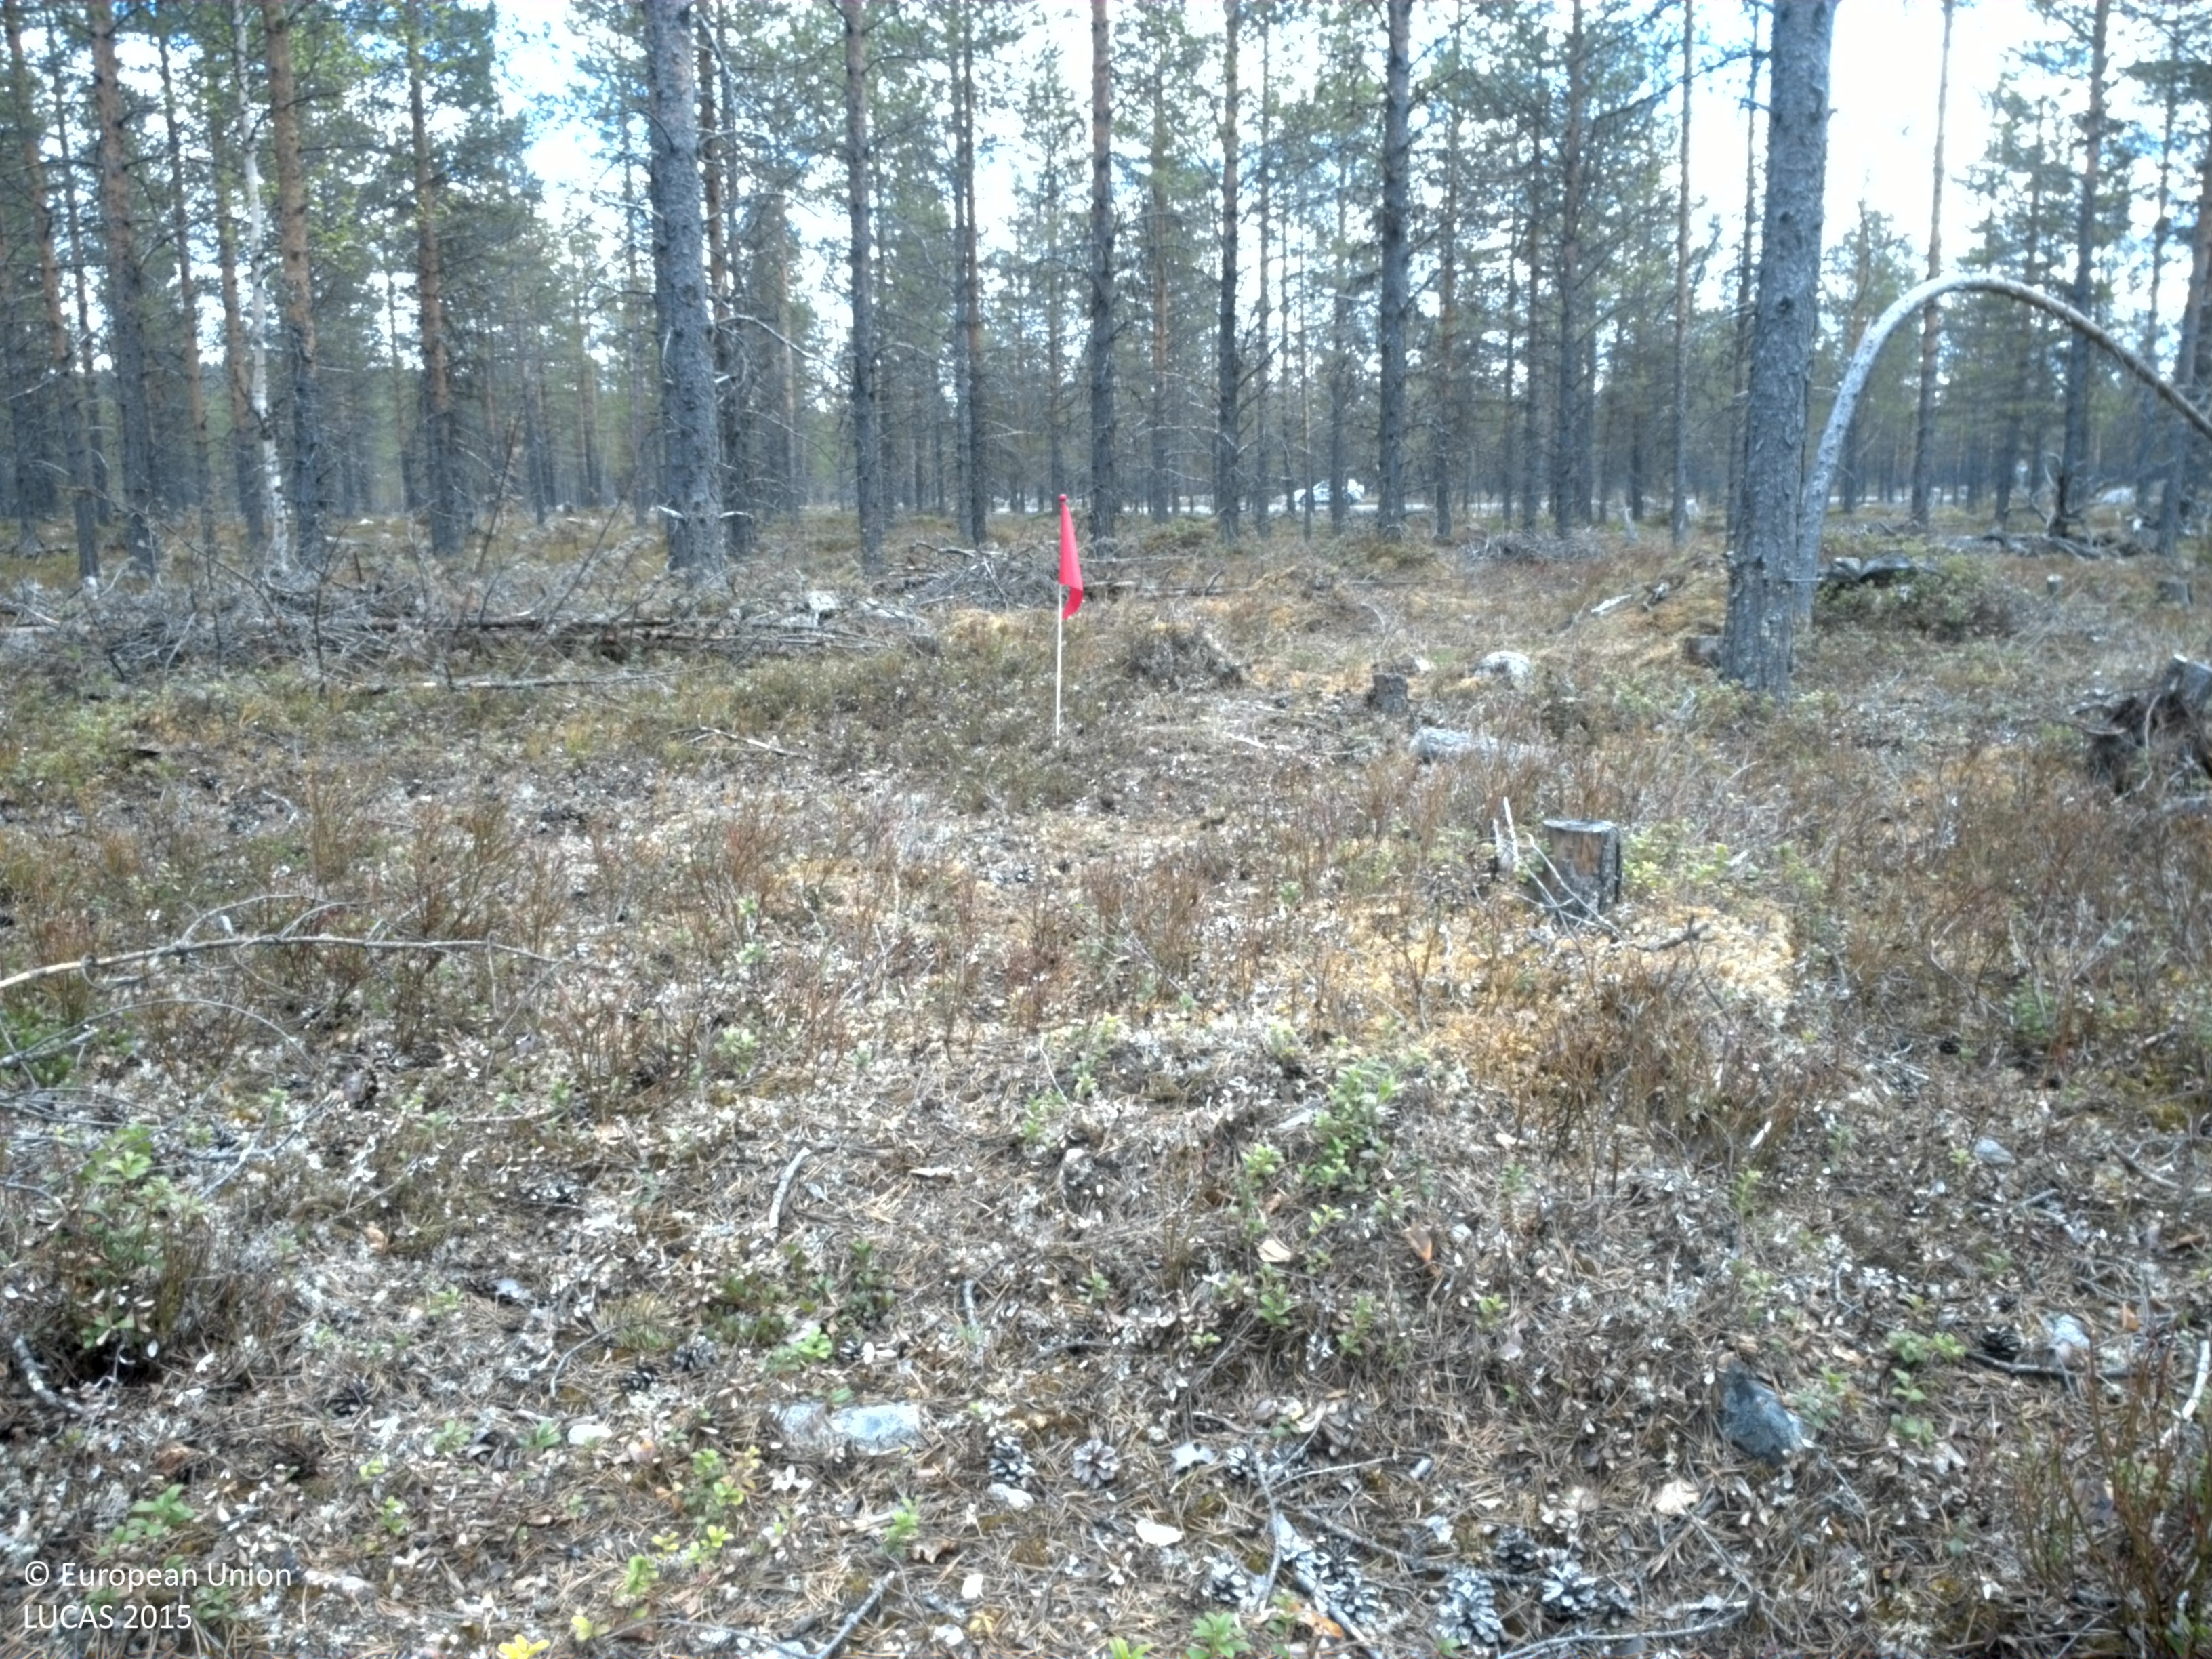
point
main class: Woodland
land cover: Pine dominated coniferous woodland
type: boreal forest
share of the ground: 25 - 50 %
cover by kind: shrubs 55 %, coniferous forest trees 40 %, lichens and mosses 5 %
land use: Forestry
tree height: > 5 m
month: June
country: SE
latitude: 66.2391
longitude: 18.6056
